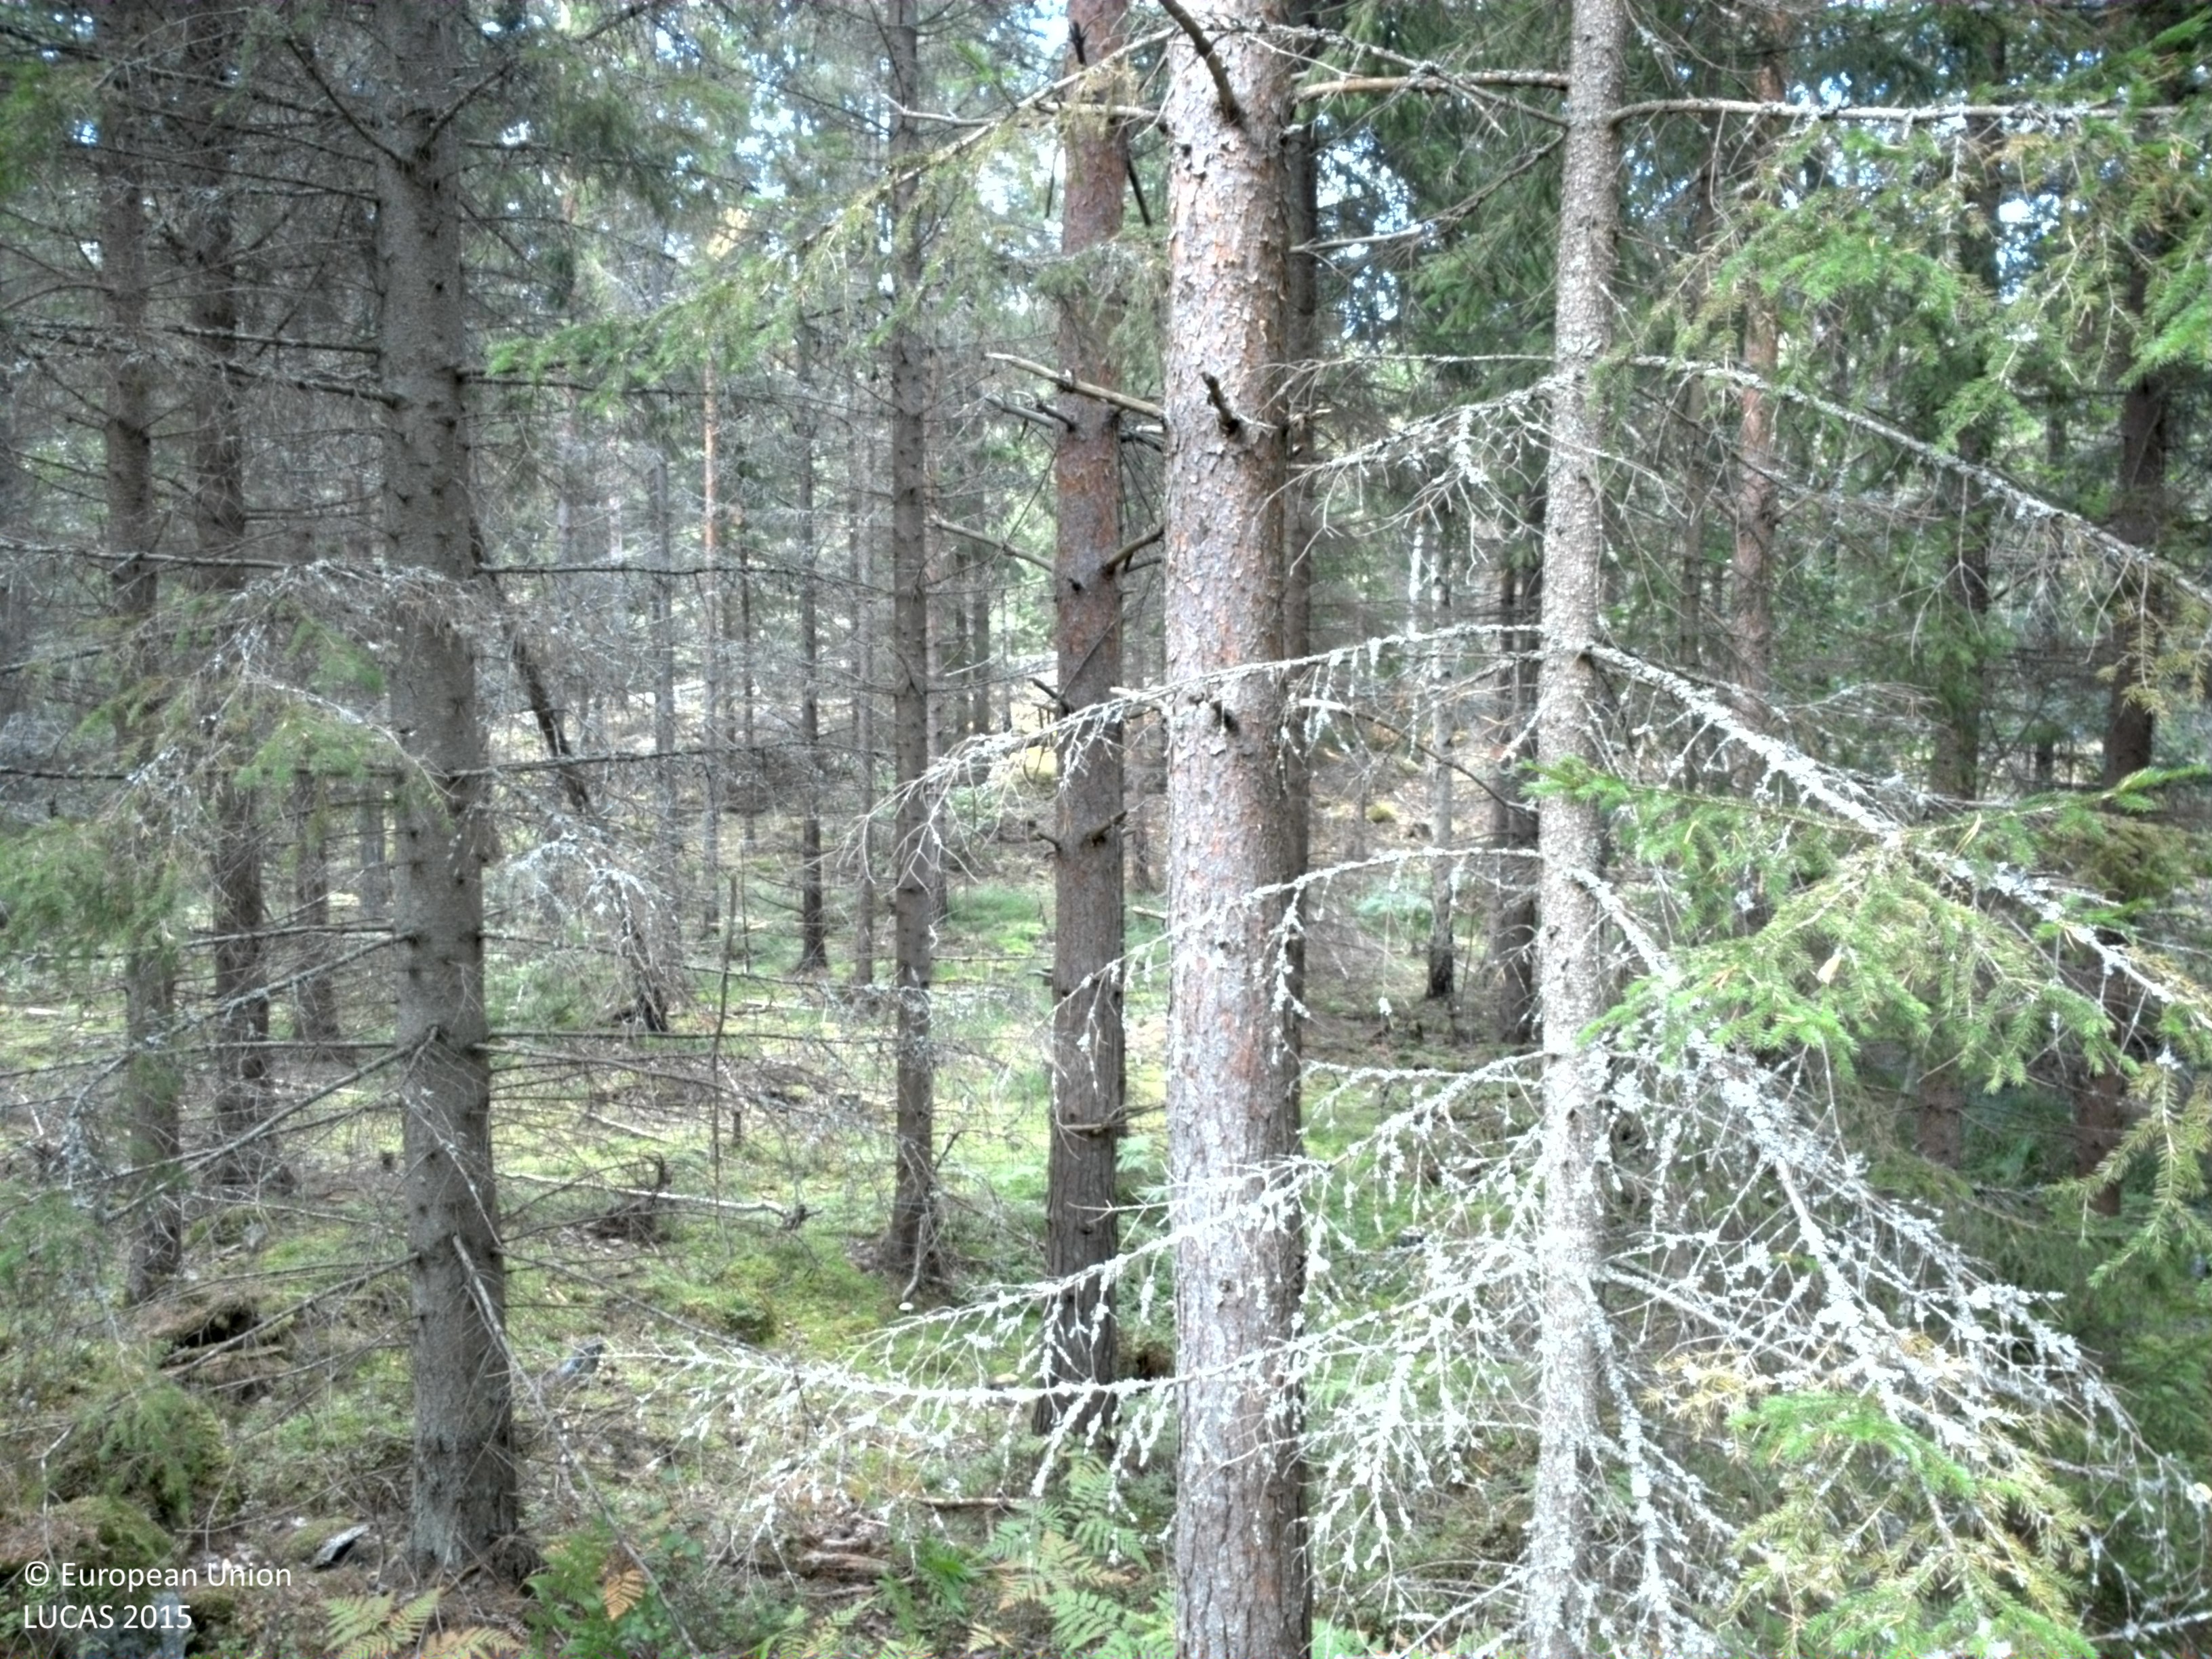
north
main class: Woodland
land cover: Pine dominated coniferous woodland
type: boreal forest
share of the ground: 50 - 75 %
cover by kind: coniferous forest trees 65 %, lichens and mosses 35 %
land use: Forestry
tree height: > 5 m
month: September
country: SE
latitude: 59.3781
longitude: 18.5373
